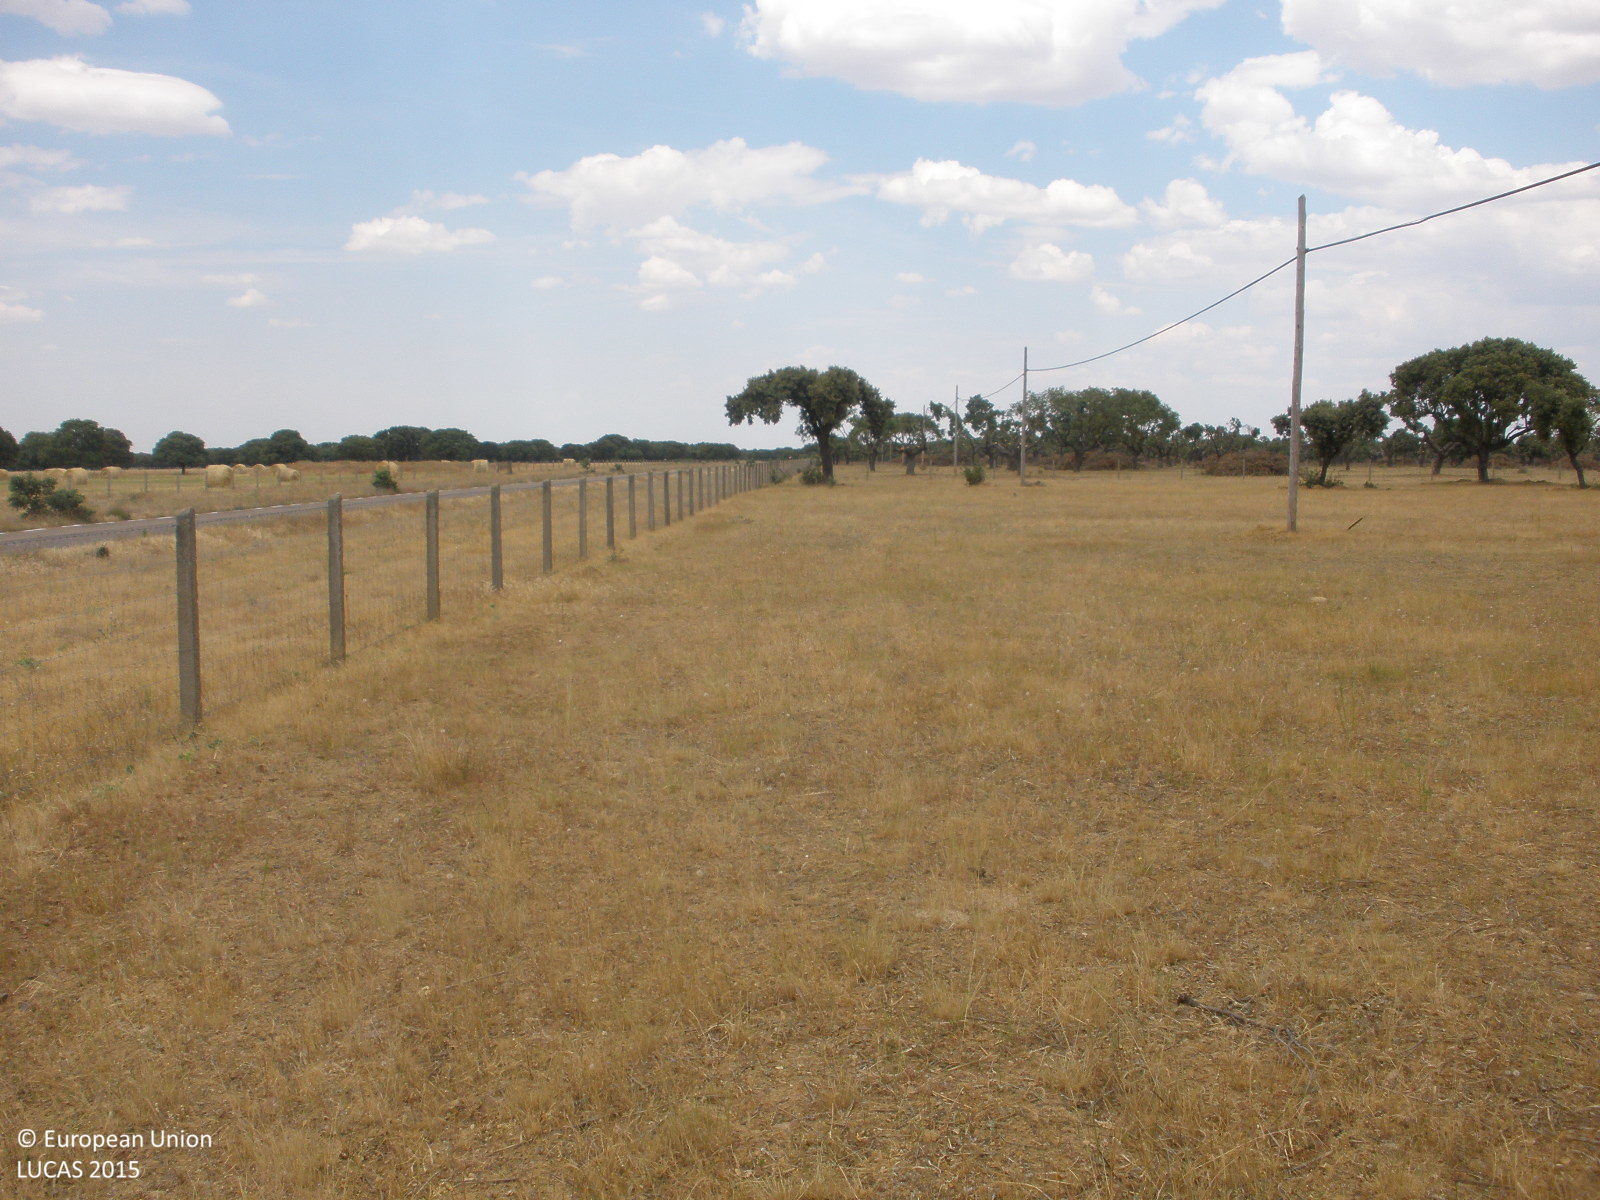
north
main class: Woodland
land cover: Broadleaved woodland
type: broadleaved evergreen forest
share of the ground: 25 - 50 %
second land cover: Grassland without tree/shrub cover
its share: > 75 %
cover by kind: herbaceous plants 70 %, broadleaved forest trees 30 %
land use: Forestry
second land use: Agriculture (excluding fallow land and kitchen gardens)
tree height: > 5 m
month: June
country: ES
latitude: 40.6447
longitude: -6.1770
